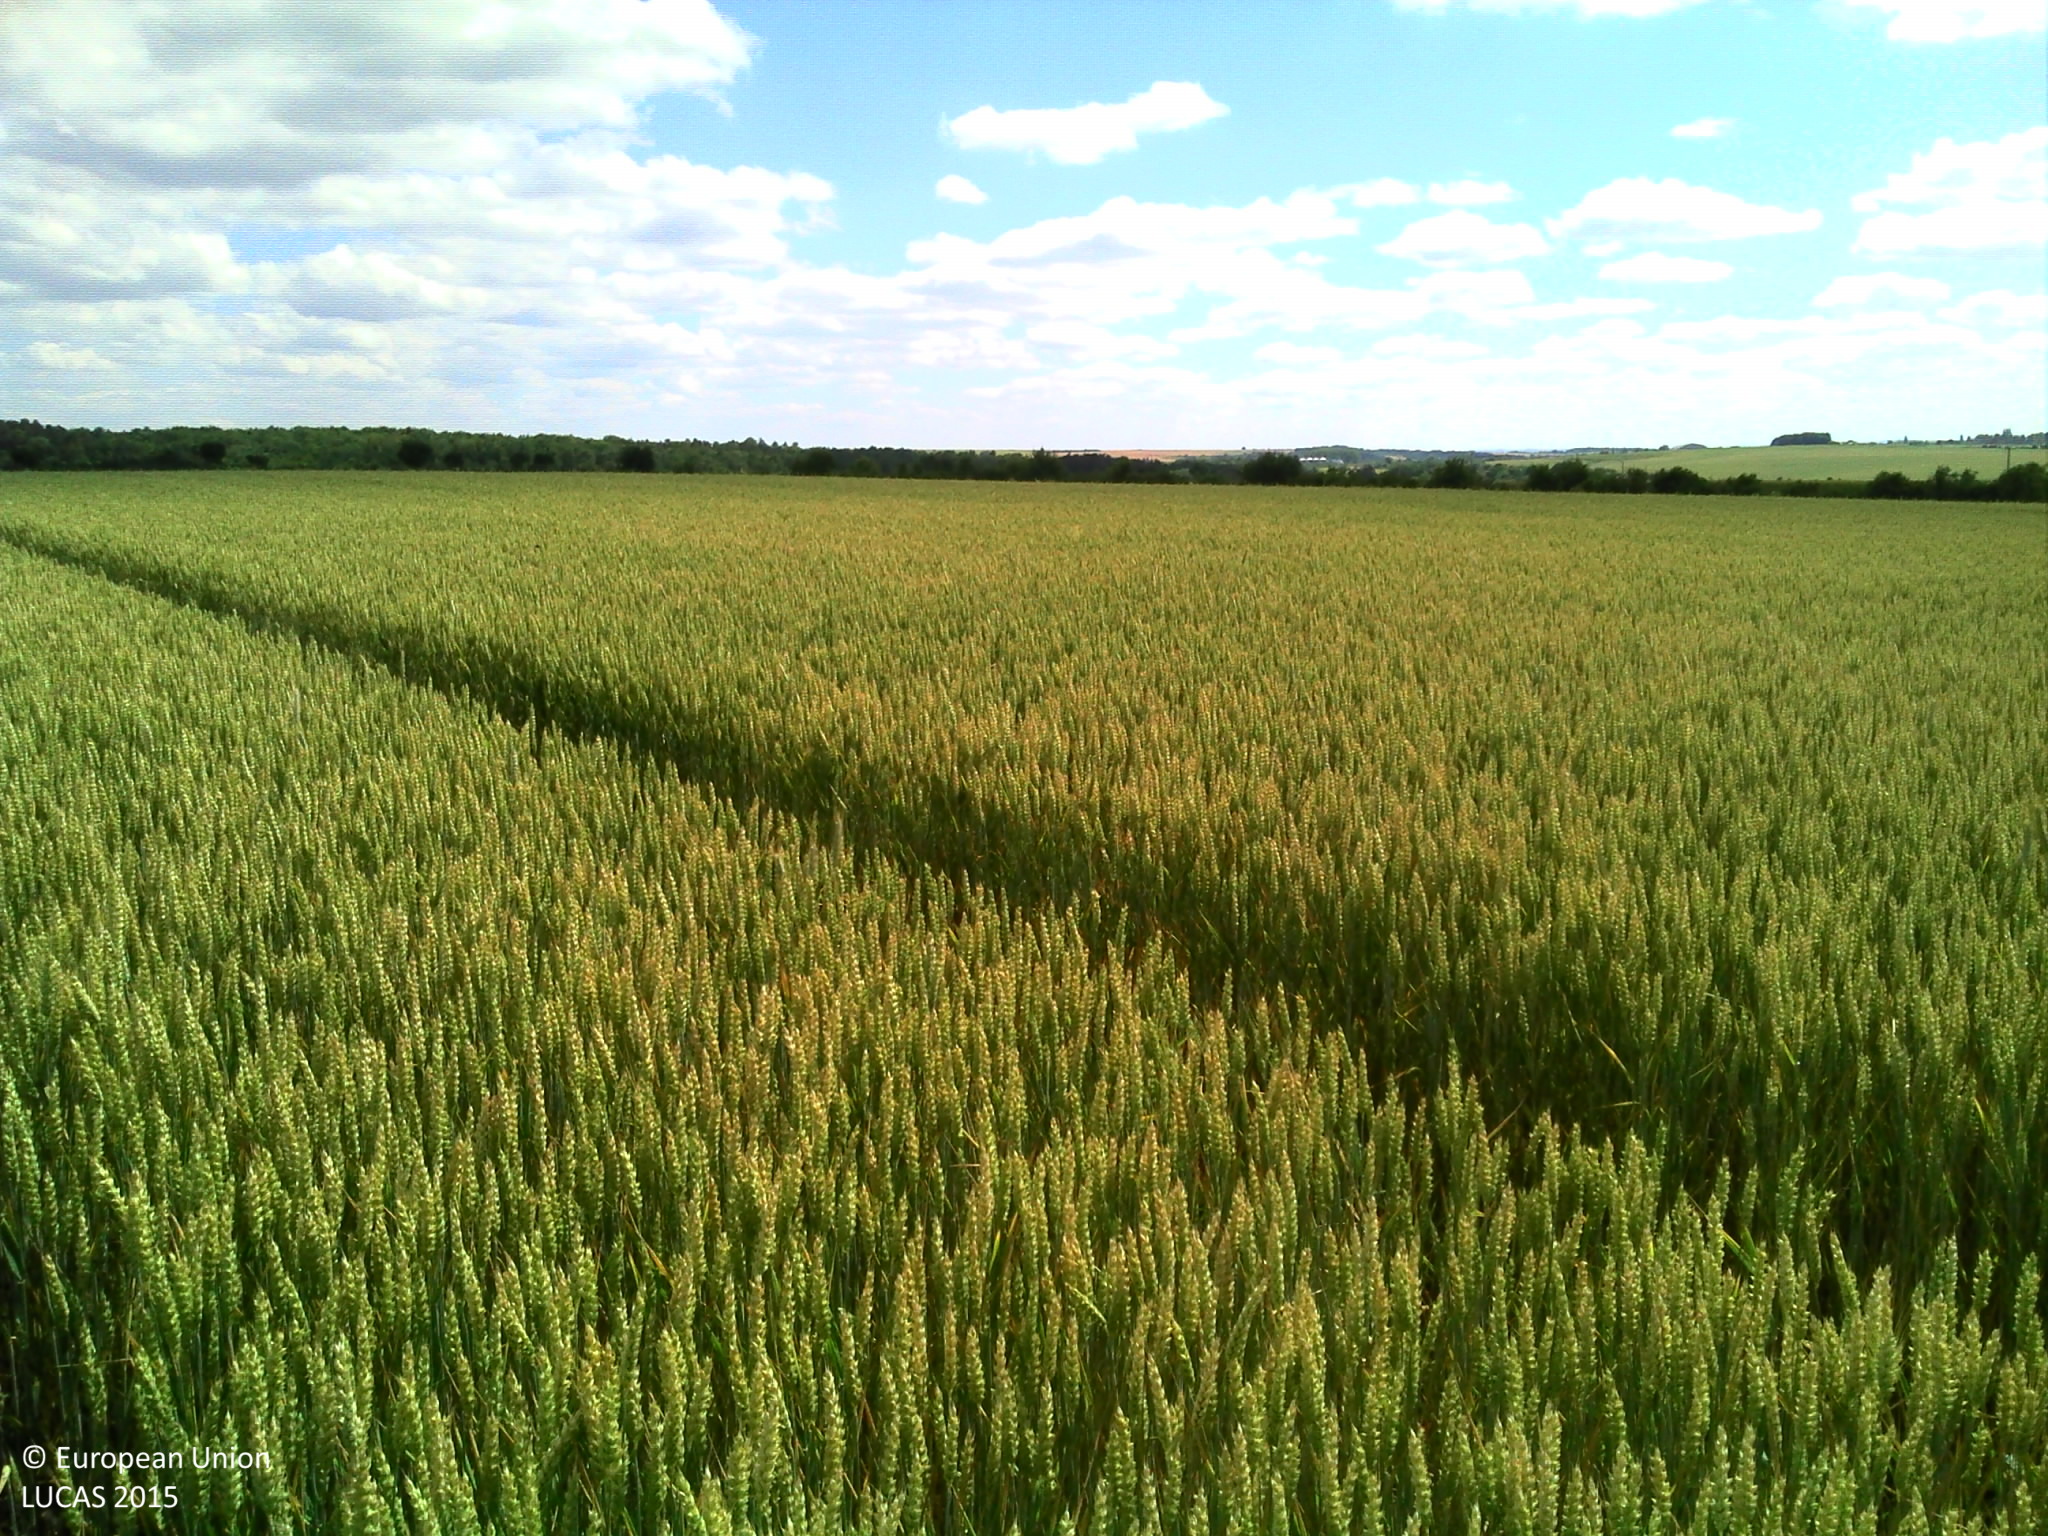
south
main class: Cropland
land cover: Common wheat
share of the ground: > 75 %
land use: Agriculture (excluding fallow land and kitchen gardens)
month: June
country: FR
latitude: 49.0484
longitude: 5.9085
